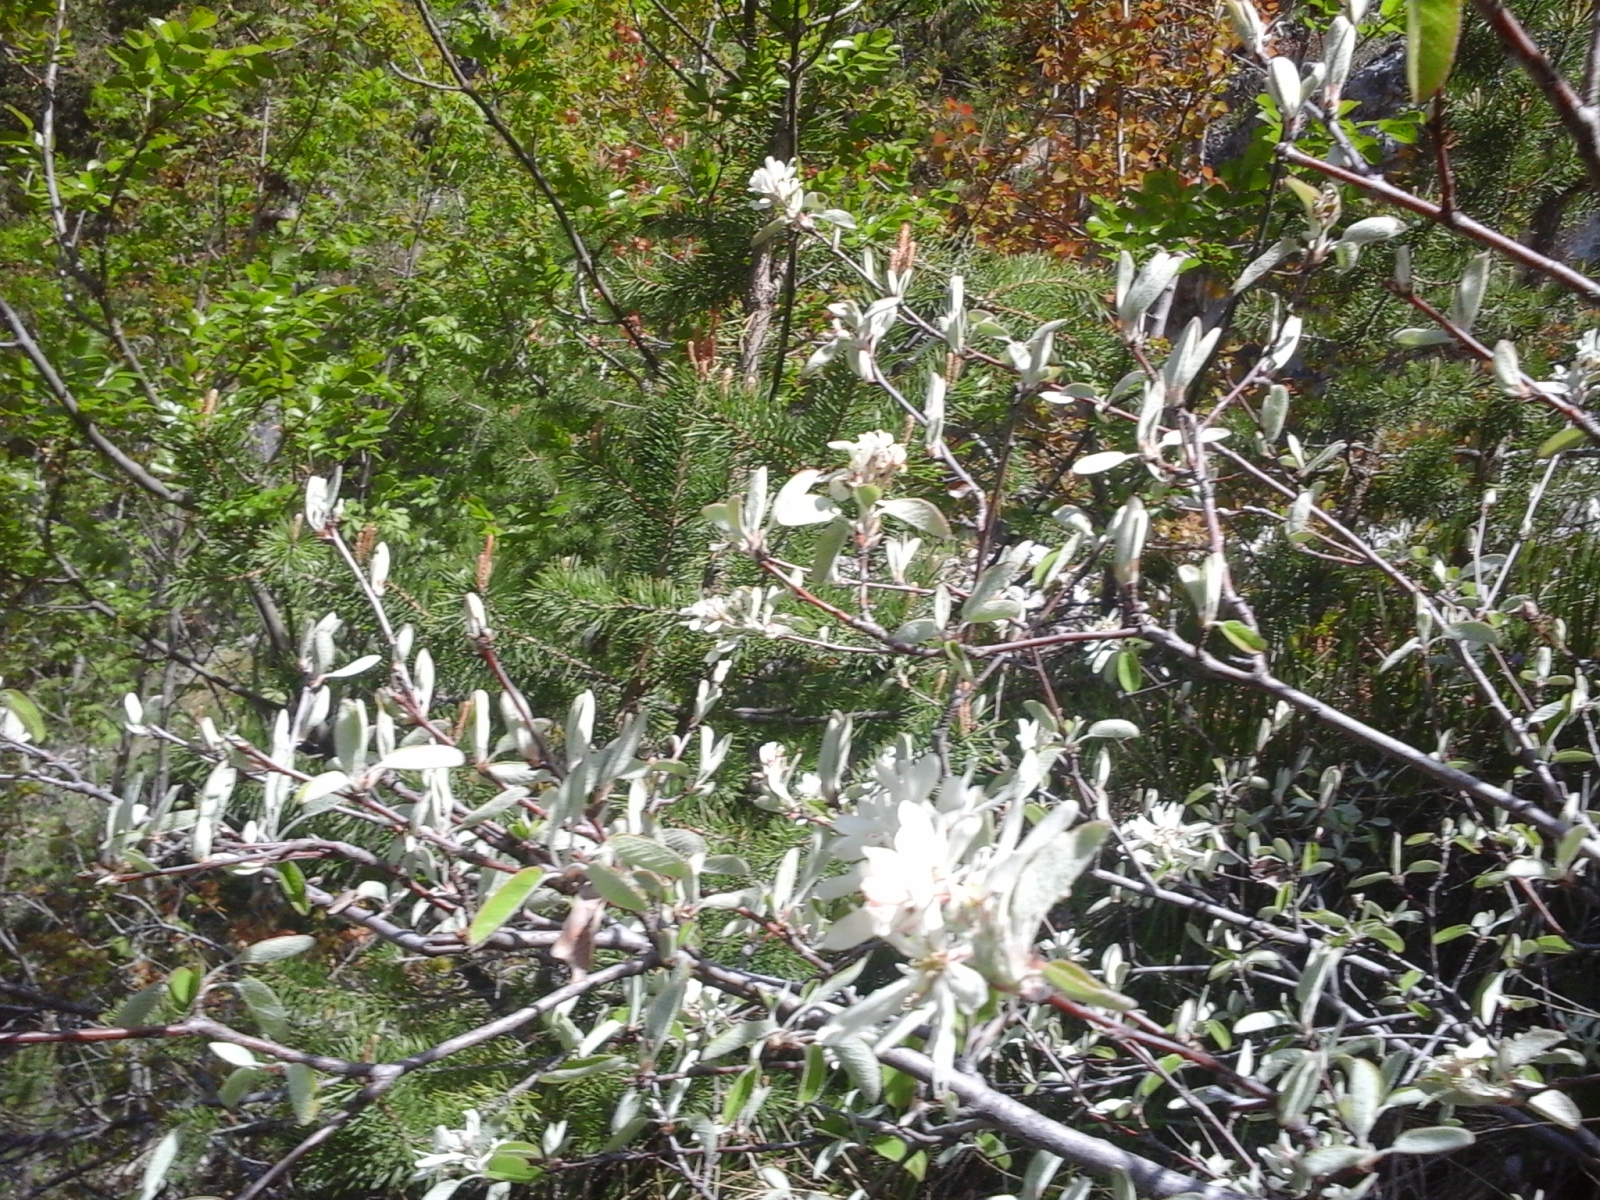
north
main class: Woodland
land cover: Other mixed woodland
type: alpine coniferous forest
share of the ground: > 75 %
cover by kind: shrubs 50 %, herbaceous plants 15 %, unconsolidated bare surface 15 %, coniferous forest trees 10 %, broadleaved forest trees 10 %
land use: Forestry
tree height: > 5 m
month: May
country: IT
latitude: 45.8628
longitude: 10.6559
